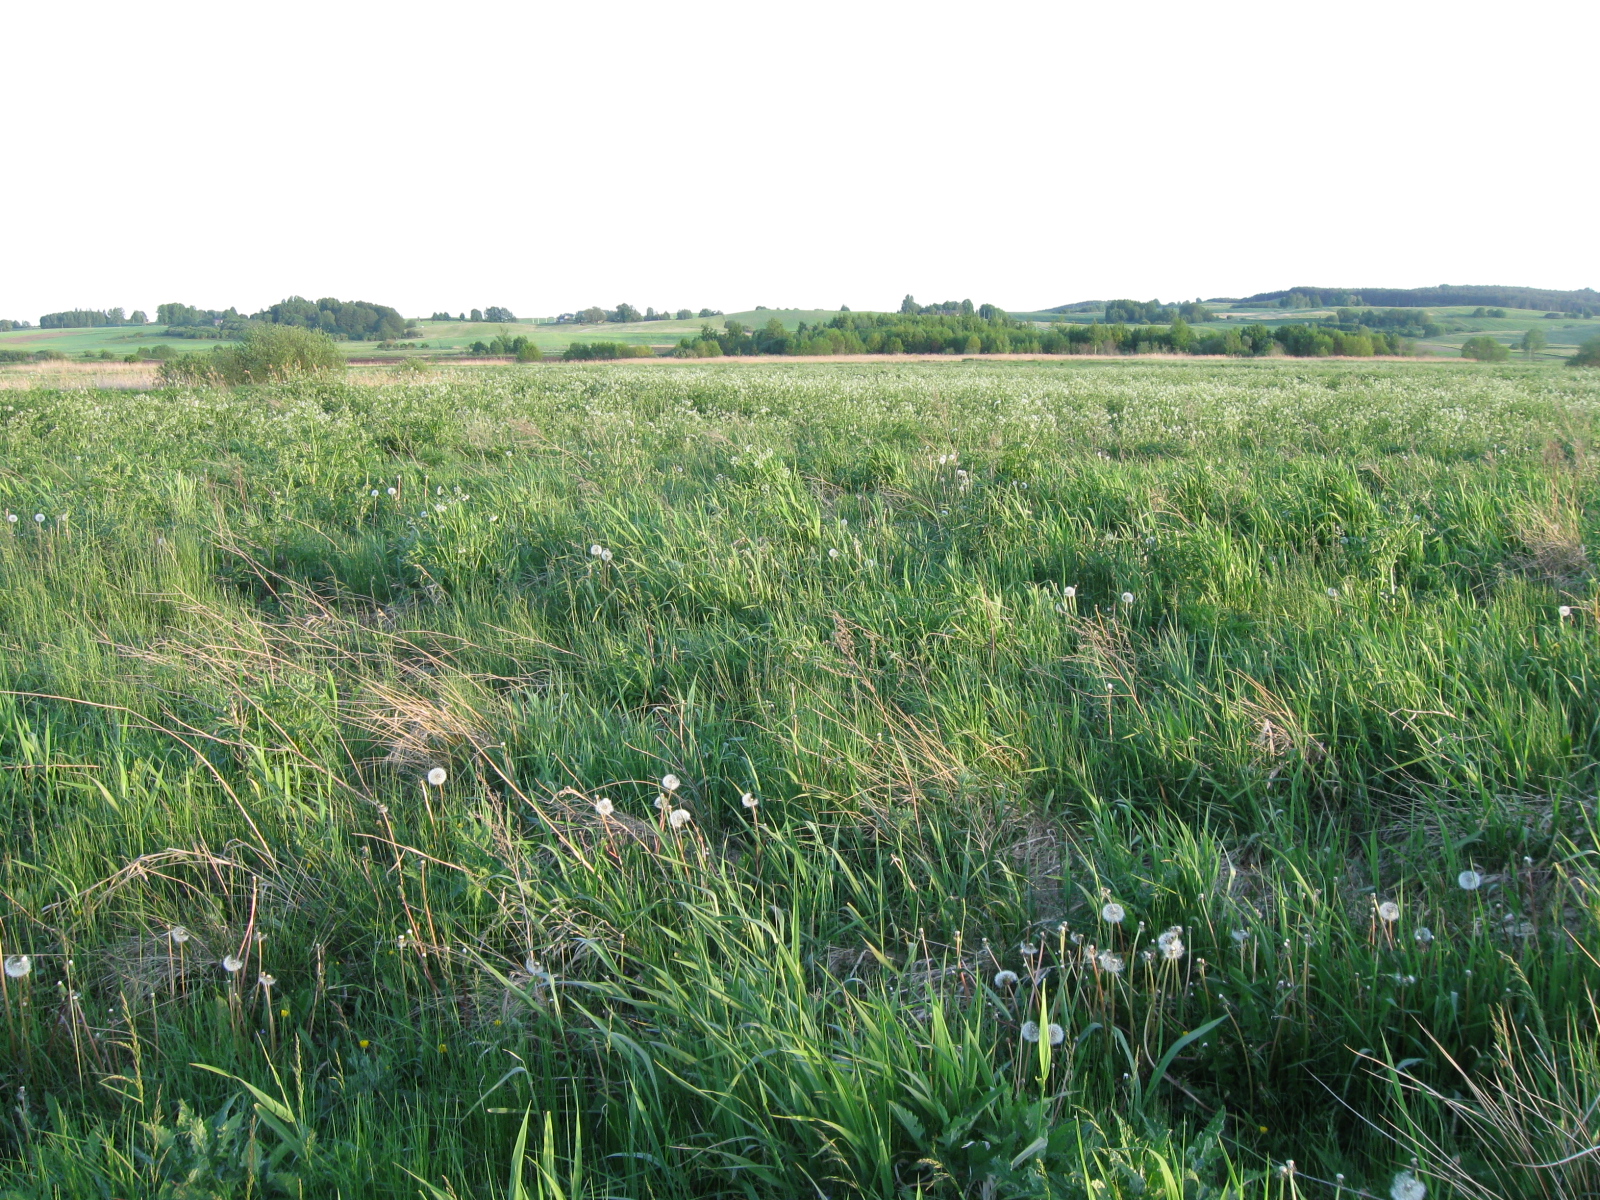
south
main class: Grassland
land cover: Grassland without tree/shrub cover
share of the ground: > 75 %
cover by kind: herbaceous plants 100 %
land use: Agriculture (excluding fallow land and kitchen gardens)
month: May
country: LT
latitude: 54.5596
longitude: 22.7955
